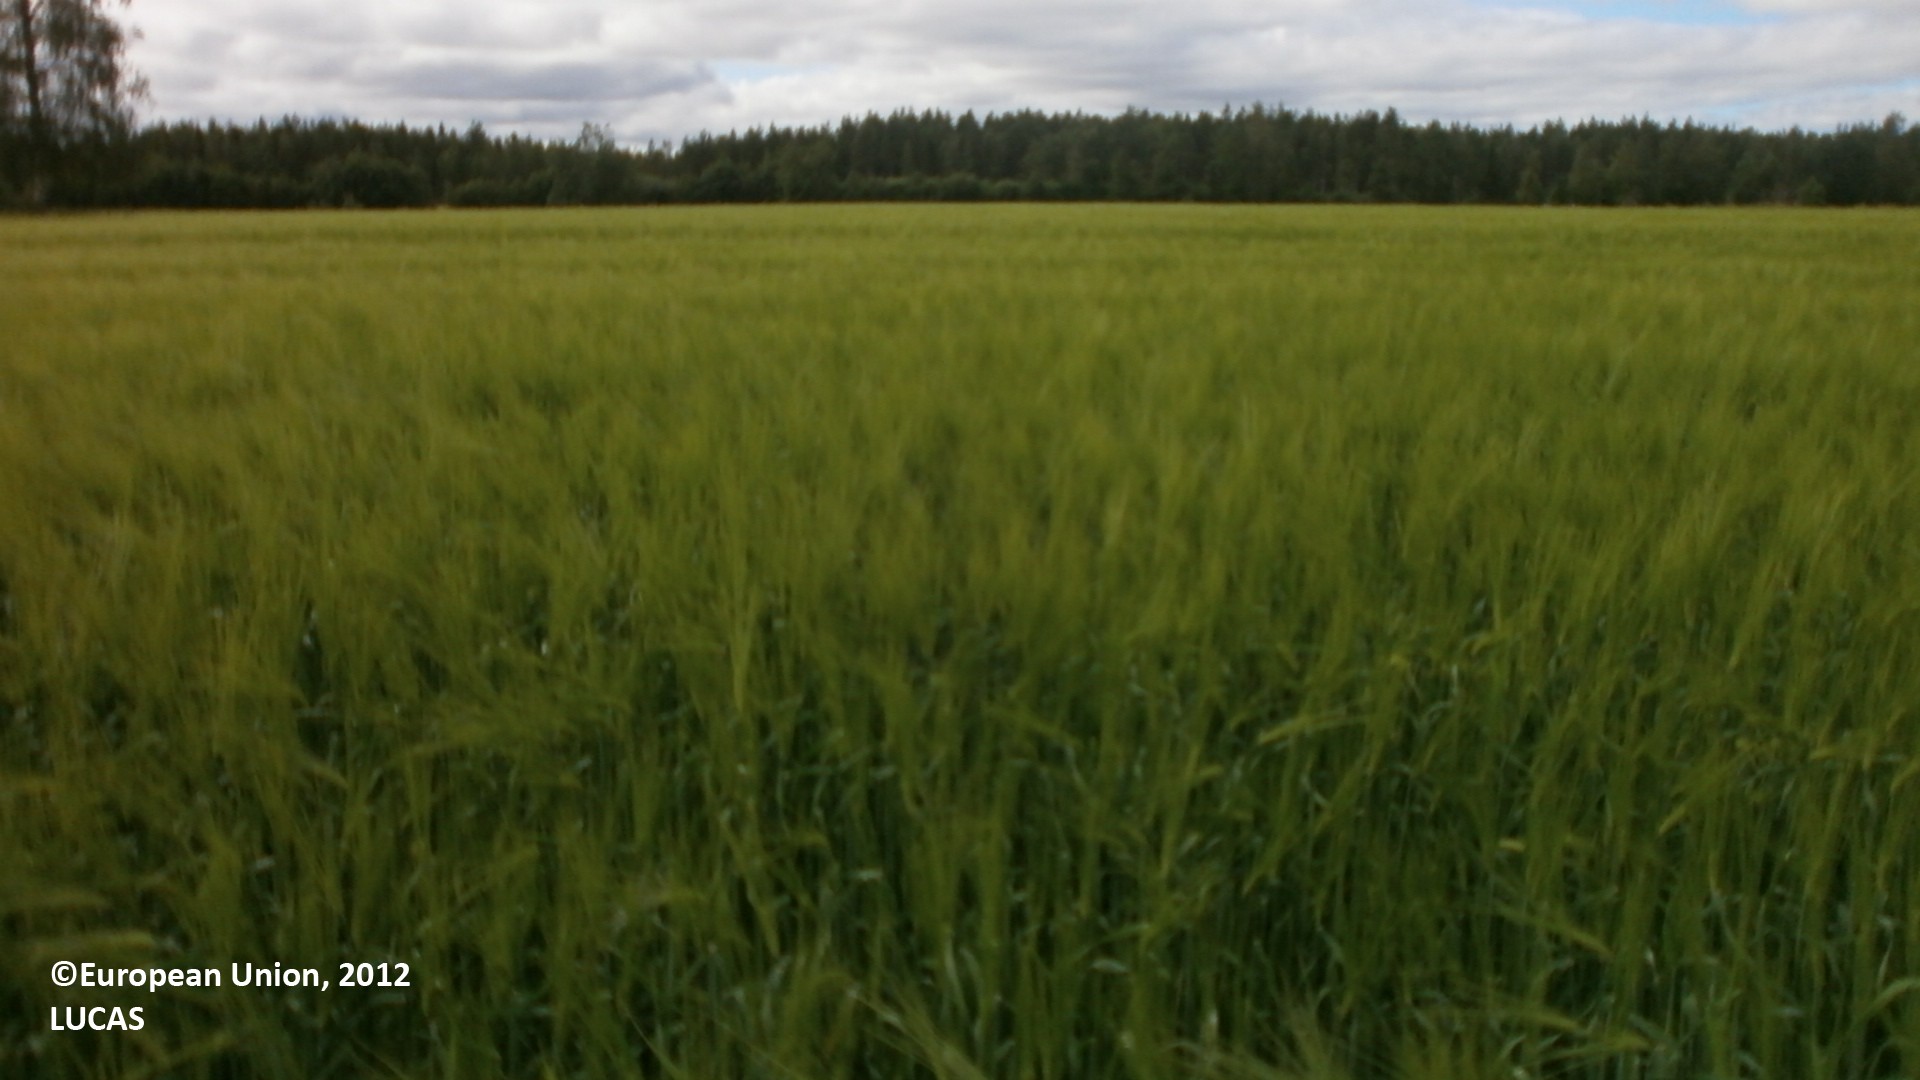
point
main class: Cropland
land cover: Barley
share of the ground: > 75 %
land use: Agriculture (excluding fallow land and kitchen gardens)
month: July
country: FI
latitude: 63.9993
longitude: 23.7388
